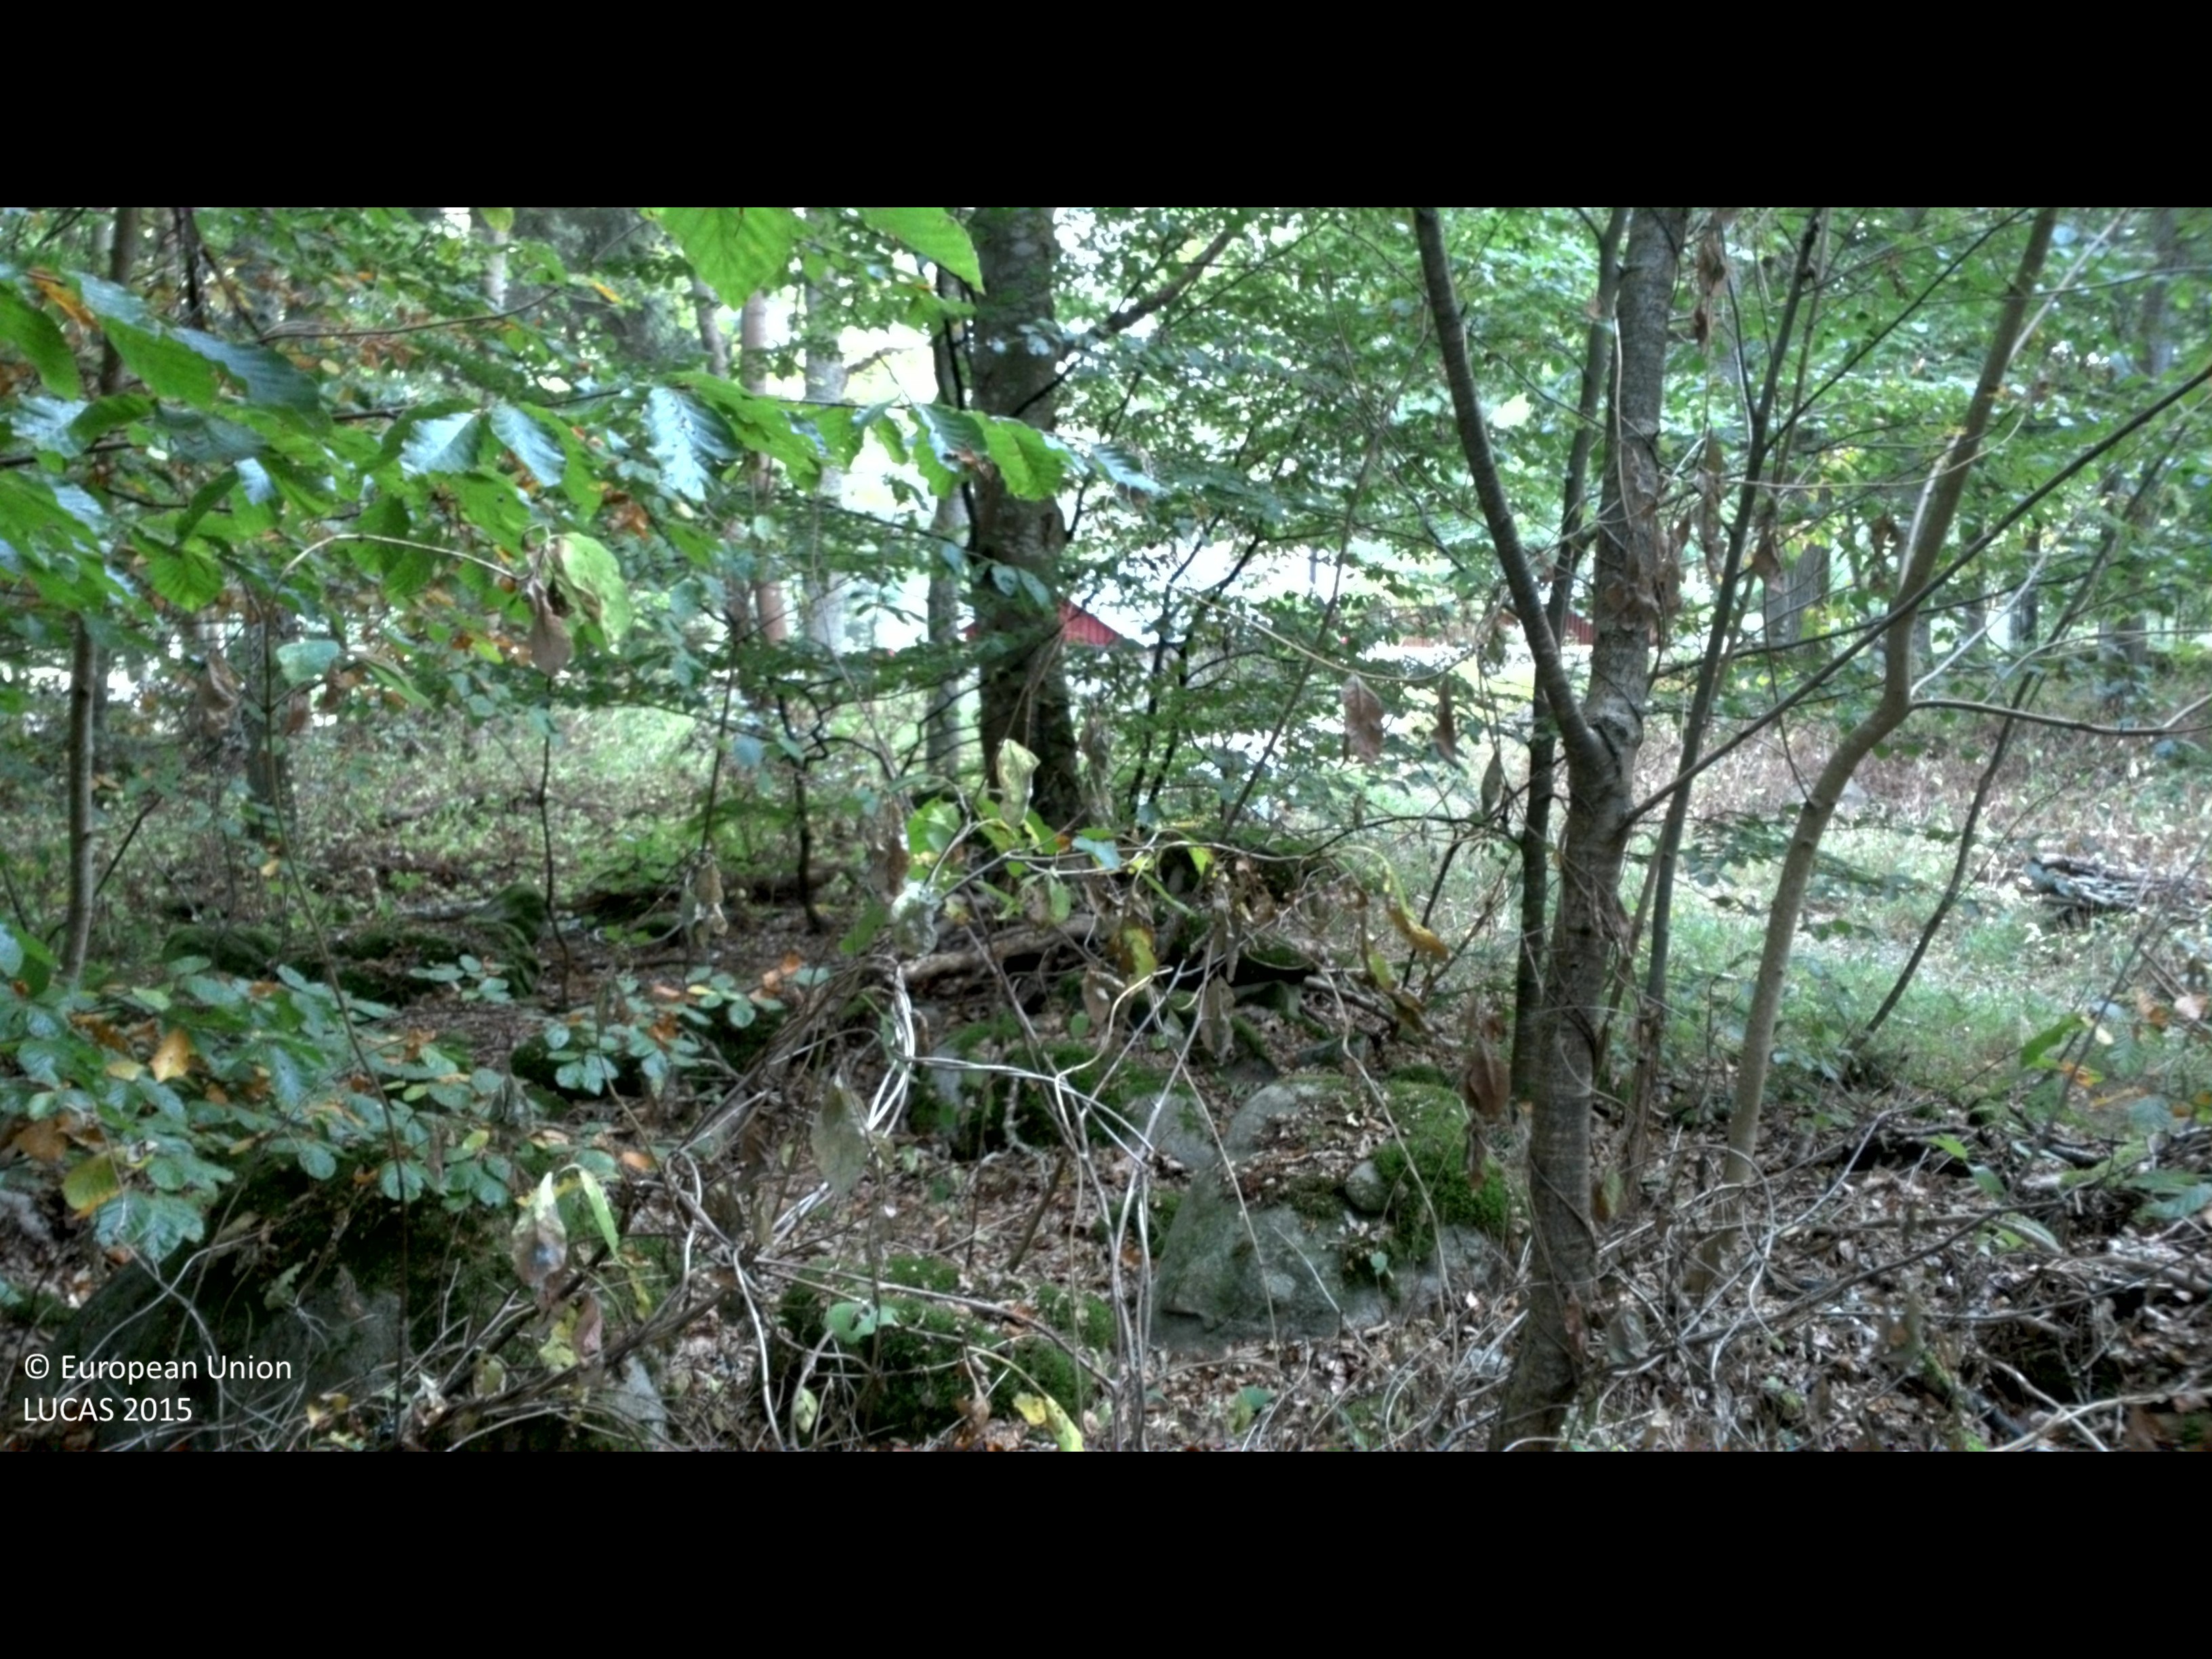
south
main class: Woodland
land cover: Broadleaved woodland
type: mesophytic deciduous forest
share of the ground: 50 - 75 %
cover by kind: broadleaved forest trees 70 %, shrubs 10 %
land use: Forestry
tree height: > 5 m
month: August
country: SE
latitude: 56.1559
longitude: 15.1670
